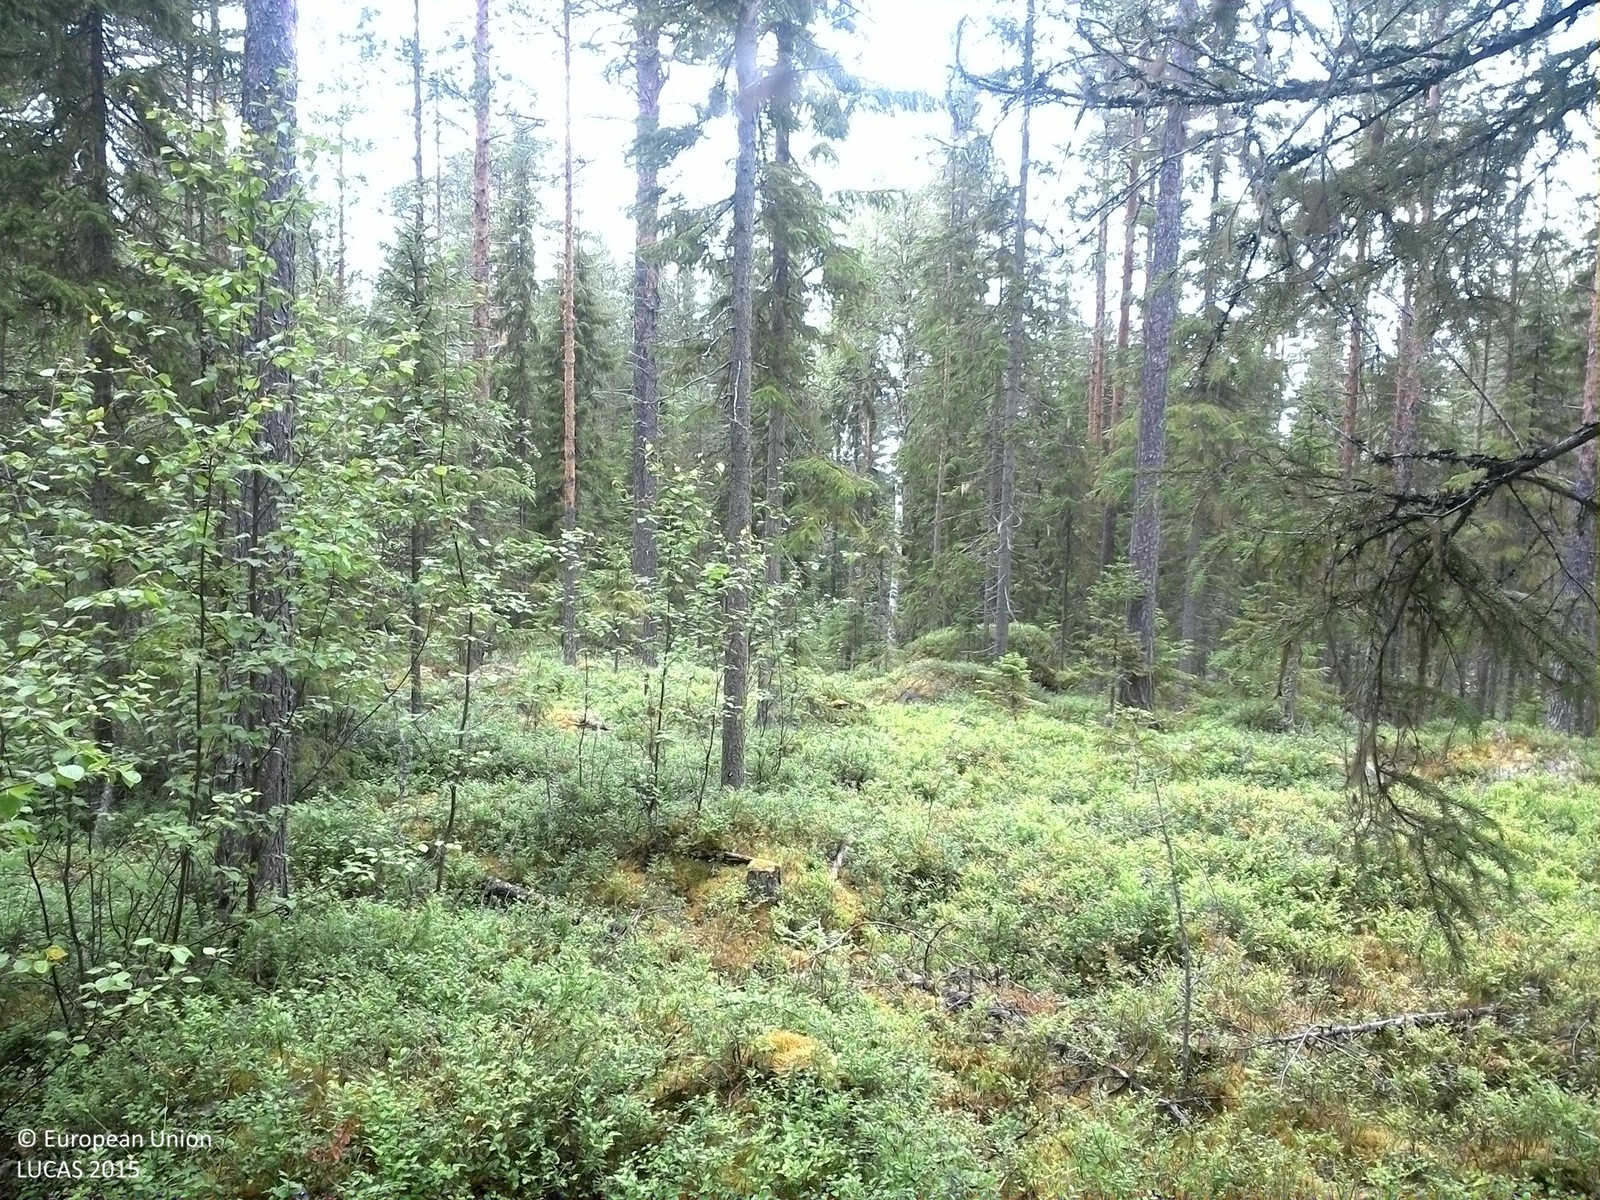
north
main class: Woodland
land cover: Pine dominated coniferous woodland
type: boreal forest
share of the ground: 25 - 50 %
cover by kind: coniferous forest trees 40 %, shrubs 35 %, lichens and mosses 15 %, broadleaved forest trees 5 %, consolidated bare surface 5 %
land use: Forestry
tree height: > 5 m
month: August
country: SE
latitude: 63.5676
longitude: 16.2760
